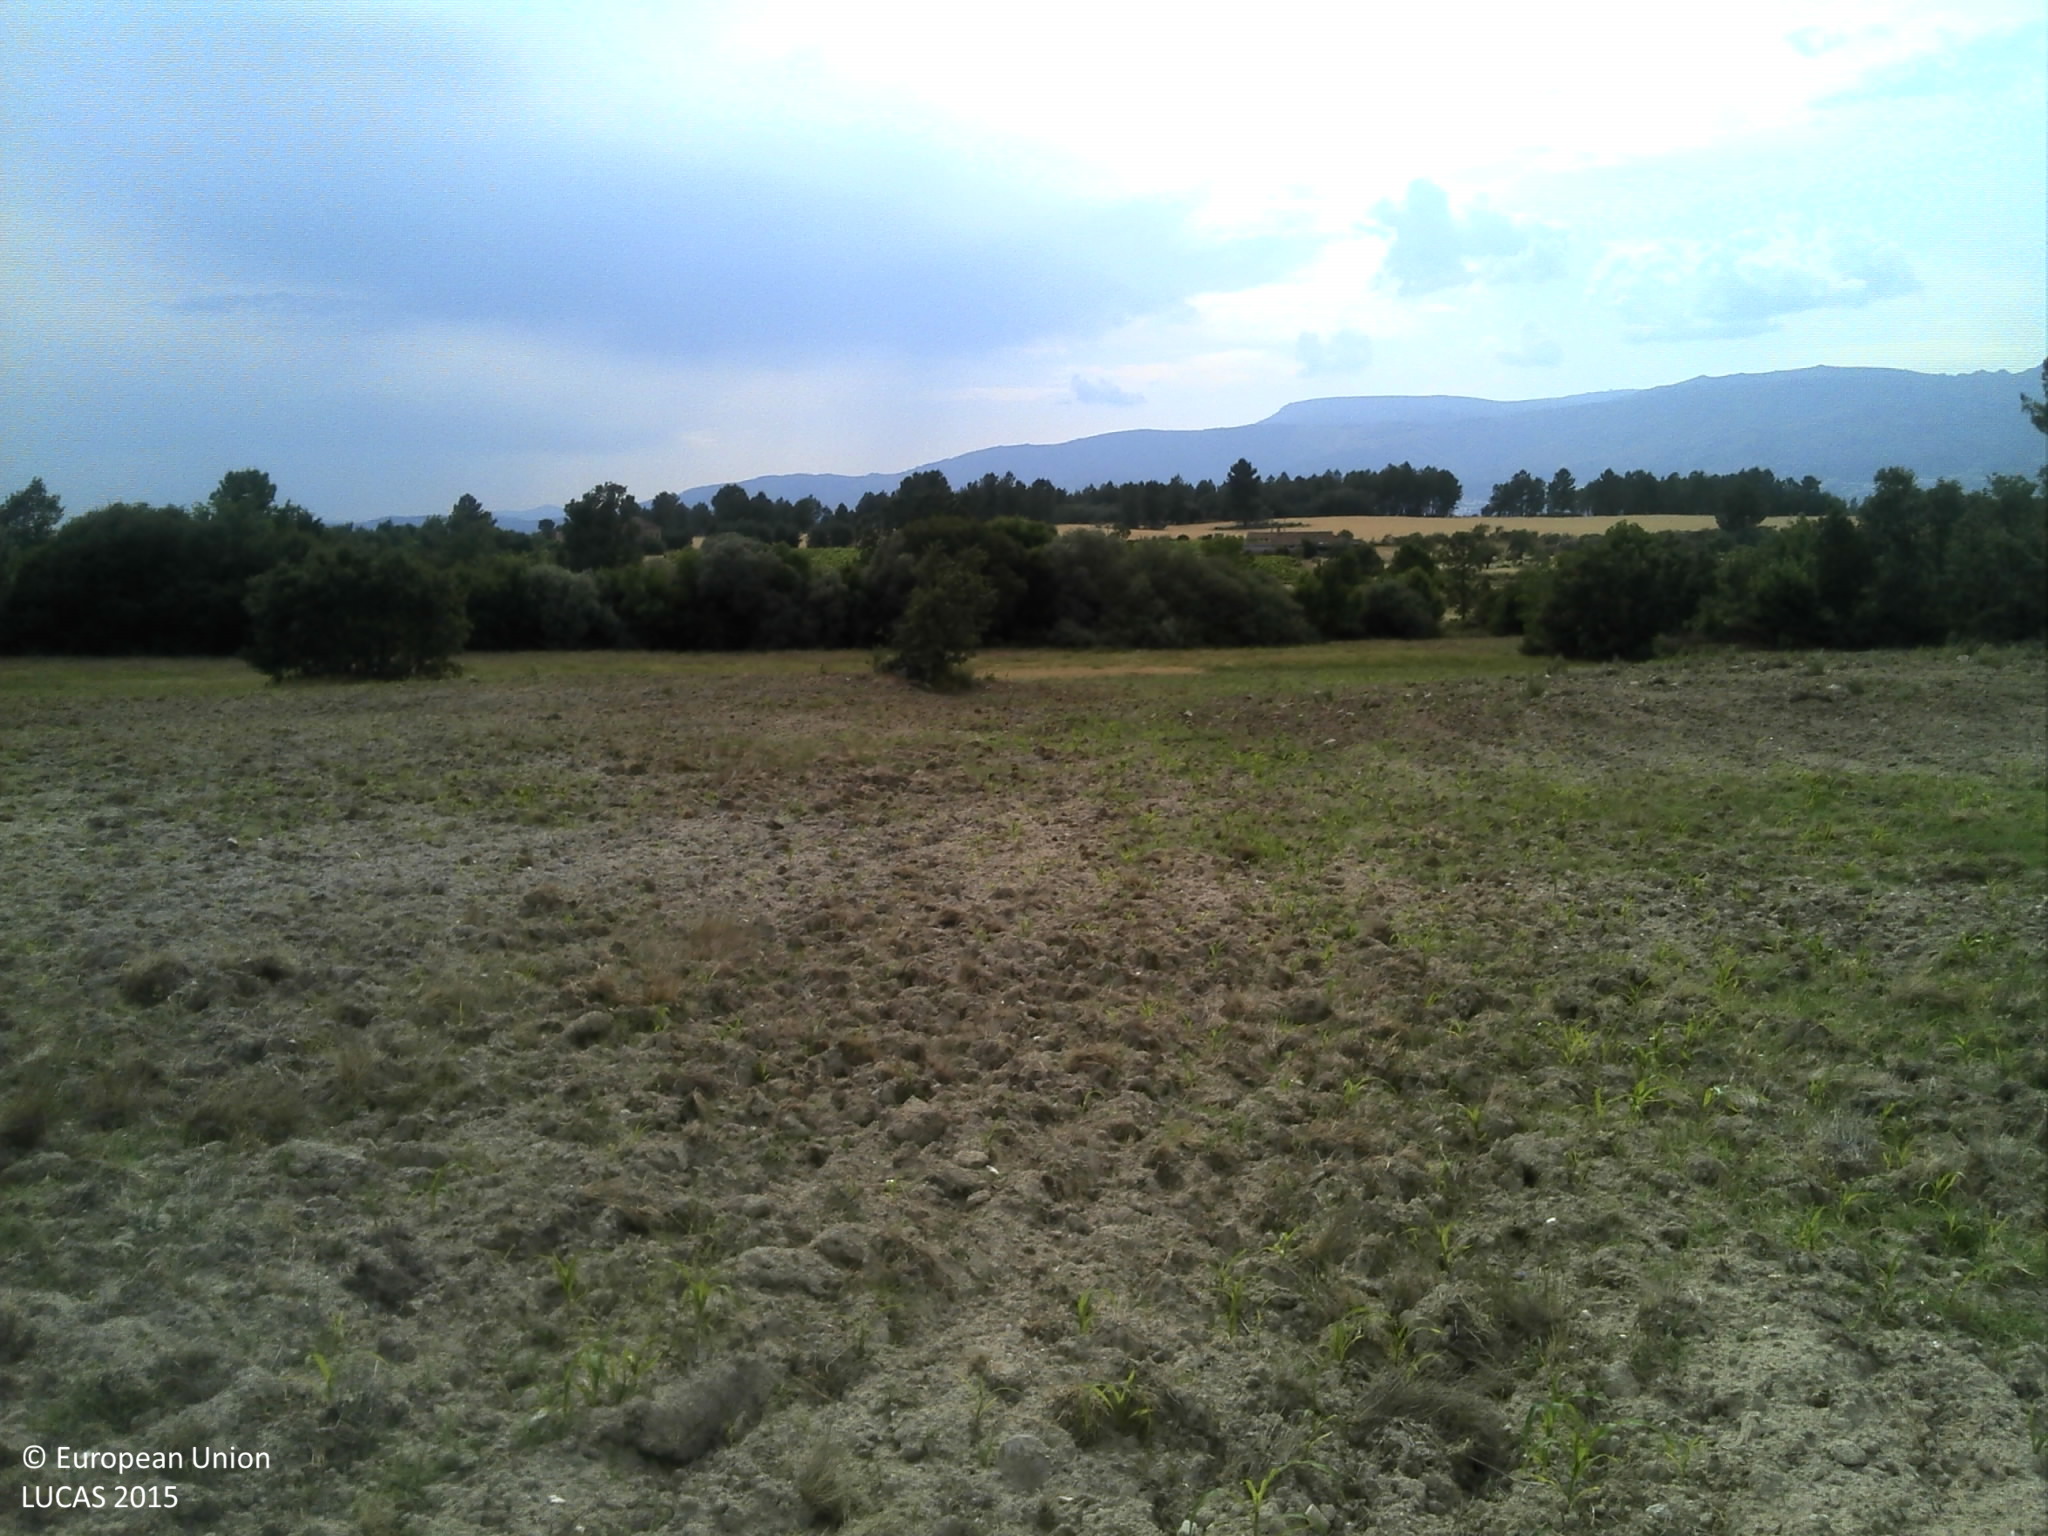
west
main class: Cropland
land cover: Maize
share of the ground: < 10 %
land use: Agriculture (excluding fallow land and kitchen gardens)
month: June
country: PT
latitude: 40.2712
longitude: -7.3794
